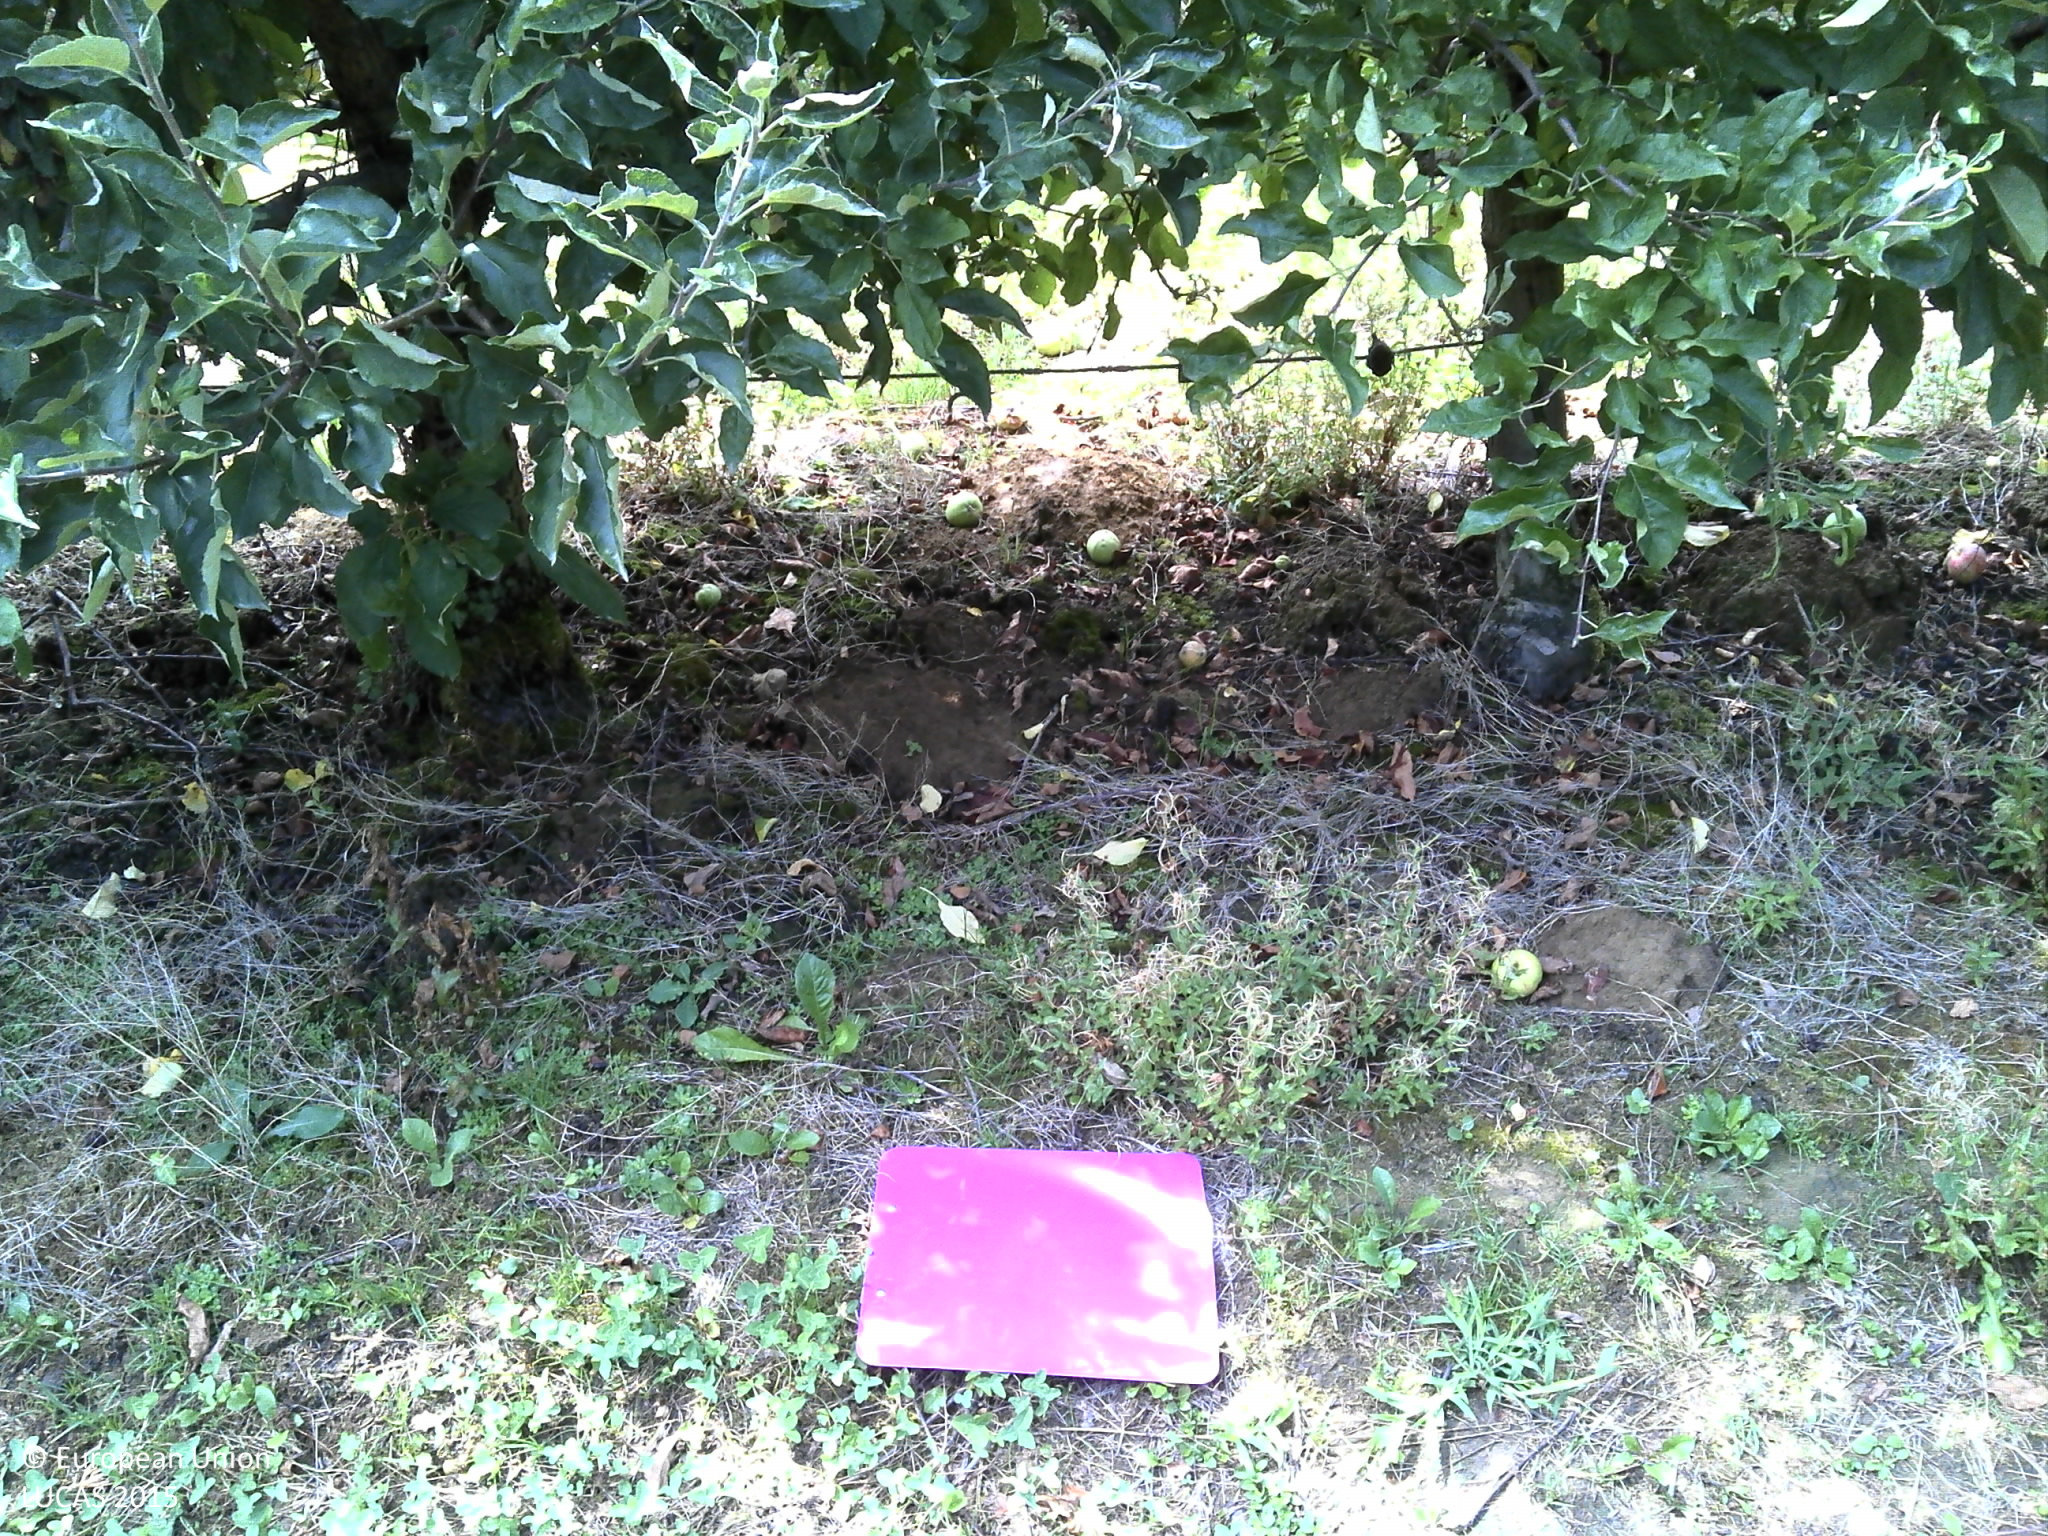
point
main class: Cropland
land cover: Apple fruit
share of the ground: > 75 %
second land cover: Spontaneously vegetated surfaces
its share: > 75 %
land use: Kitchen garden
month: July
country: HR
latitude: 45.6393
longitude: 16.6318
